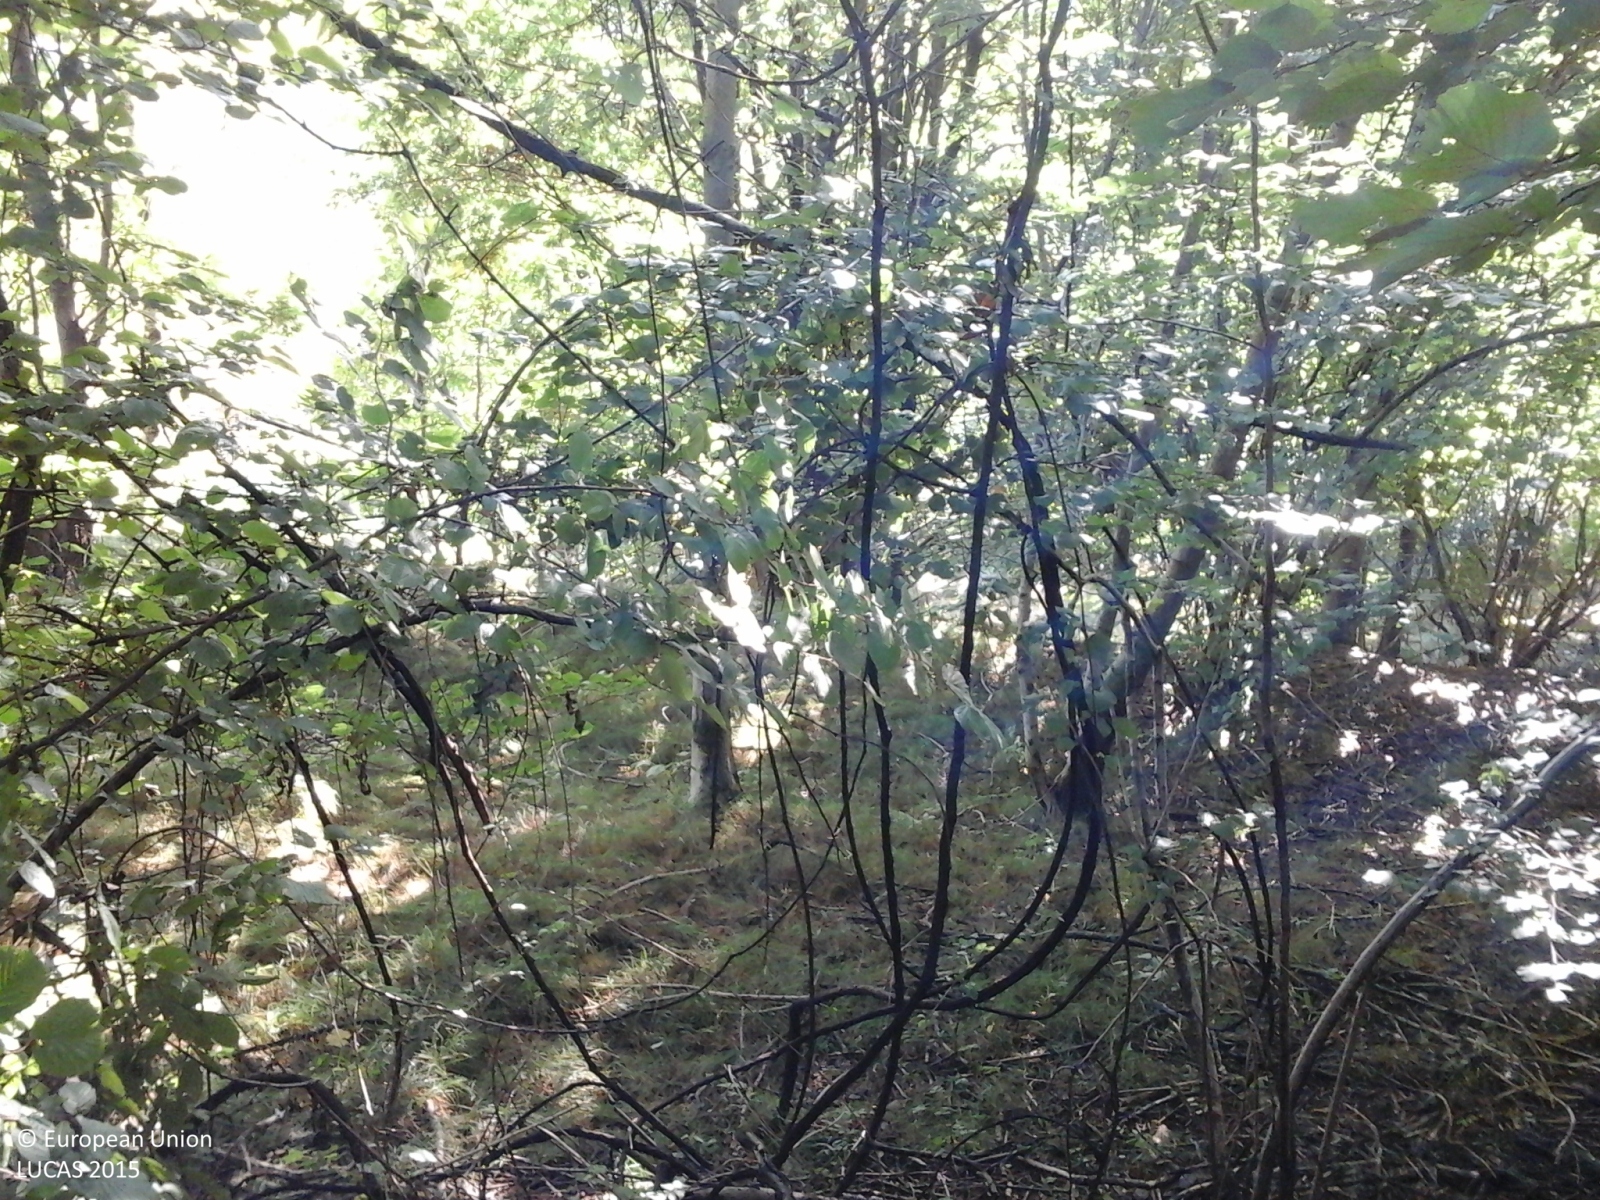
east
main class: Woodland
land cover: Broadleaved woodland
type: thermophilous deciduous forest
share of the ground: > 75 %
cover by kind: broadleaved forest trees 85 %, herbaceous plants 10 %, unconsolidated bare surface 5 %
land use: Forestry
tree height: > 5 m
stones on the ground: < 10 %
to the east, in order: Broadleaved woodland; Grass margins; Paved roads, cycling and walking lanes; Grass margins; Fences; Other mixed woodland; Artificial constructions in urban areas; Broadleaved woodland; Fences; Broadleaved woodland; Electric lines; Broadleaved woodland
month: August
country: IT
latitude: 45.9509
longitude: 9.0854
